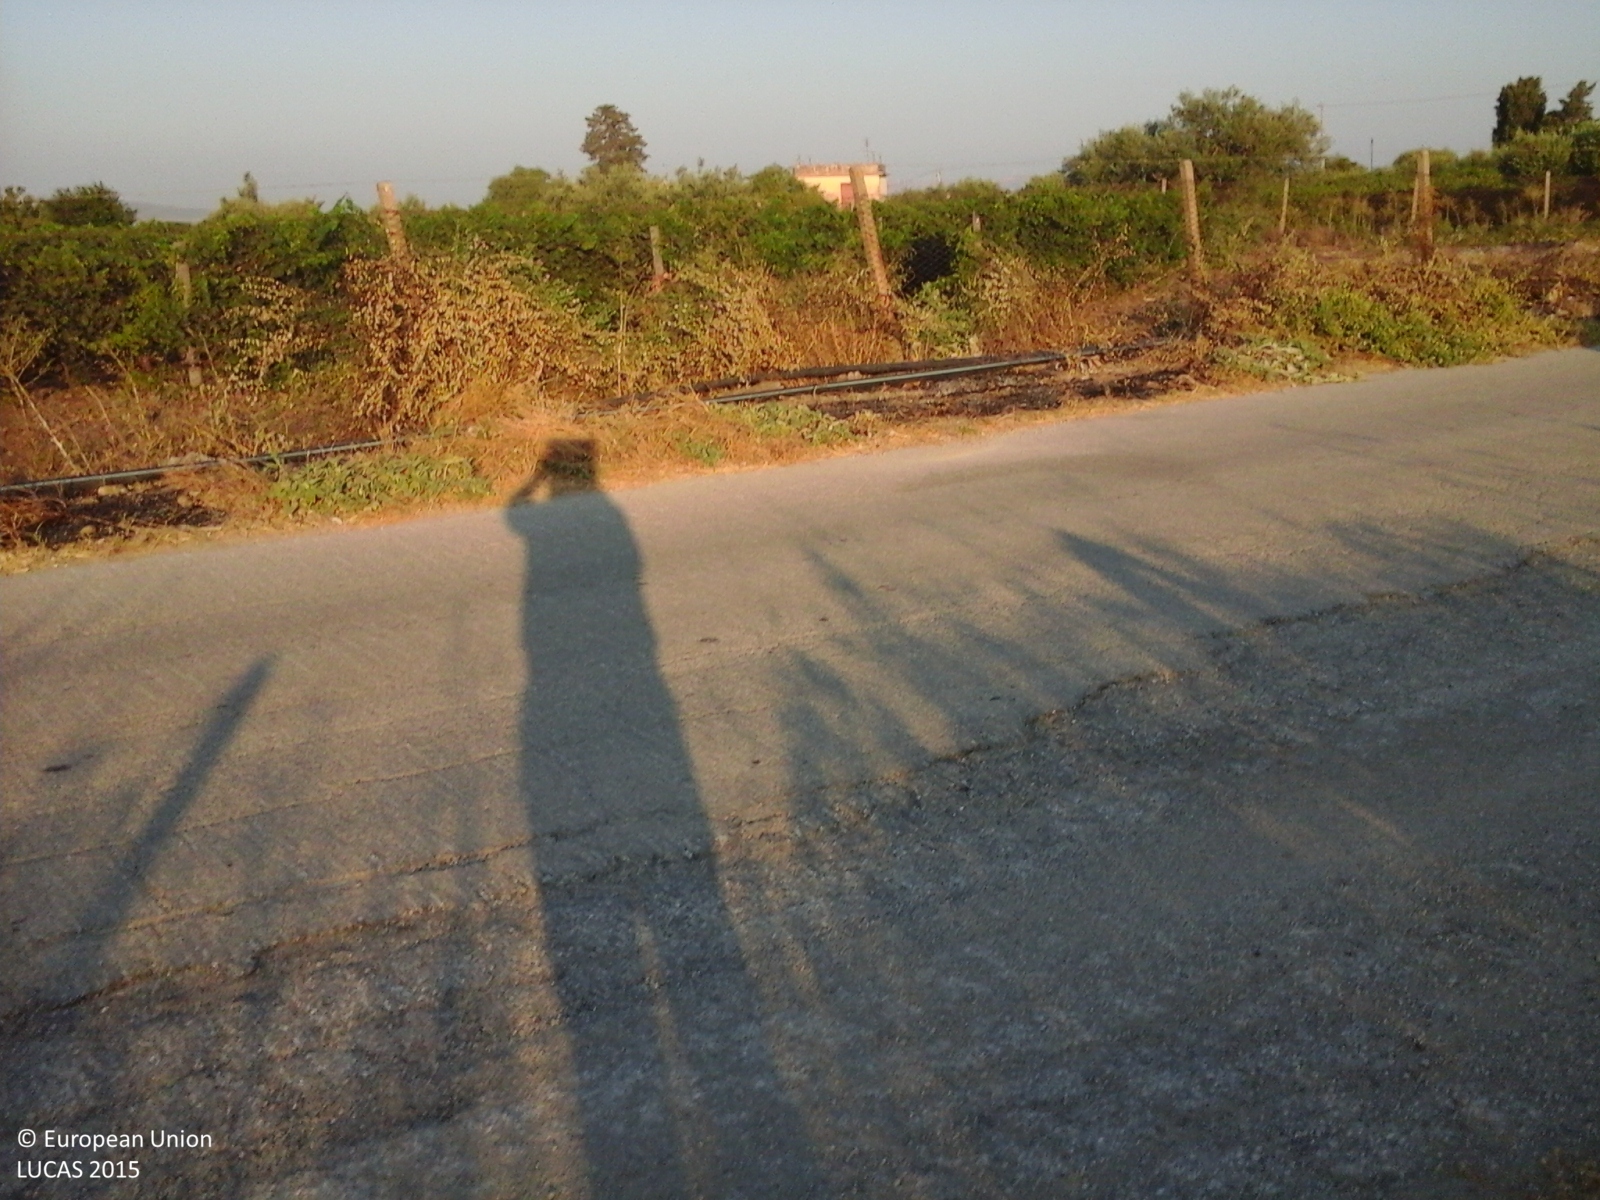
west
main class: Cropland
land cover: Durum wheat
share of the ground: > 75 %
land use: Agriculture (excluding fallow land and kitchen gardens)
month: July
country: IT
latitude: 37.1893
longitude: 14.0351
